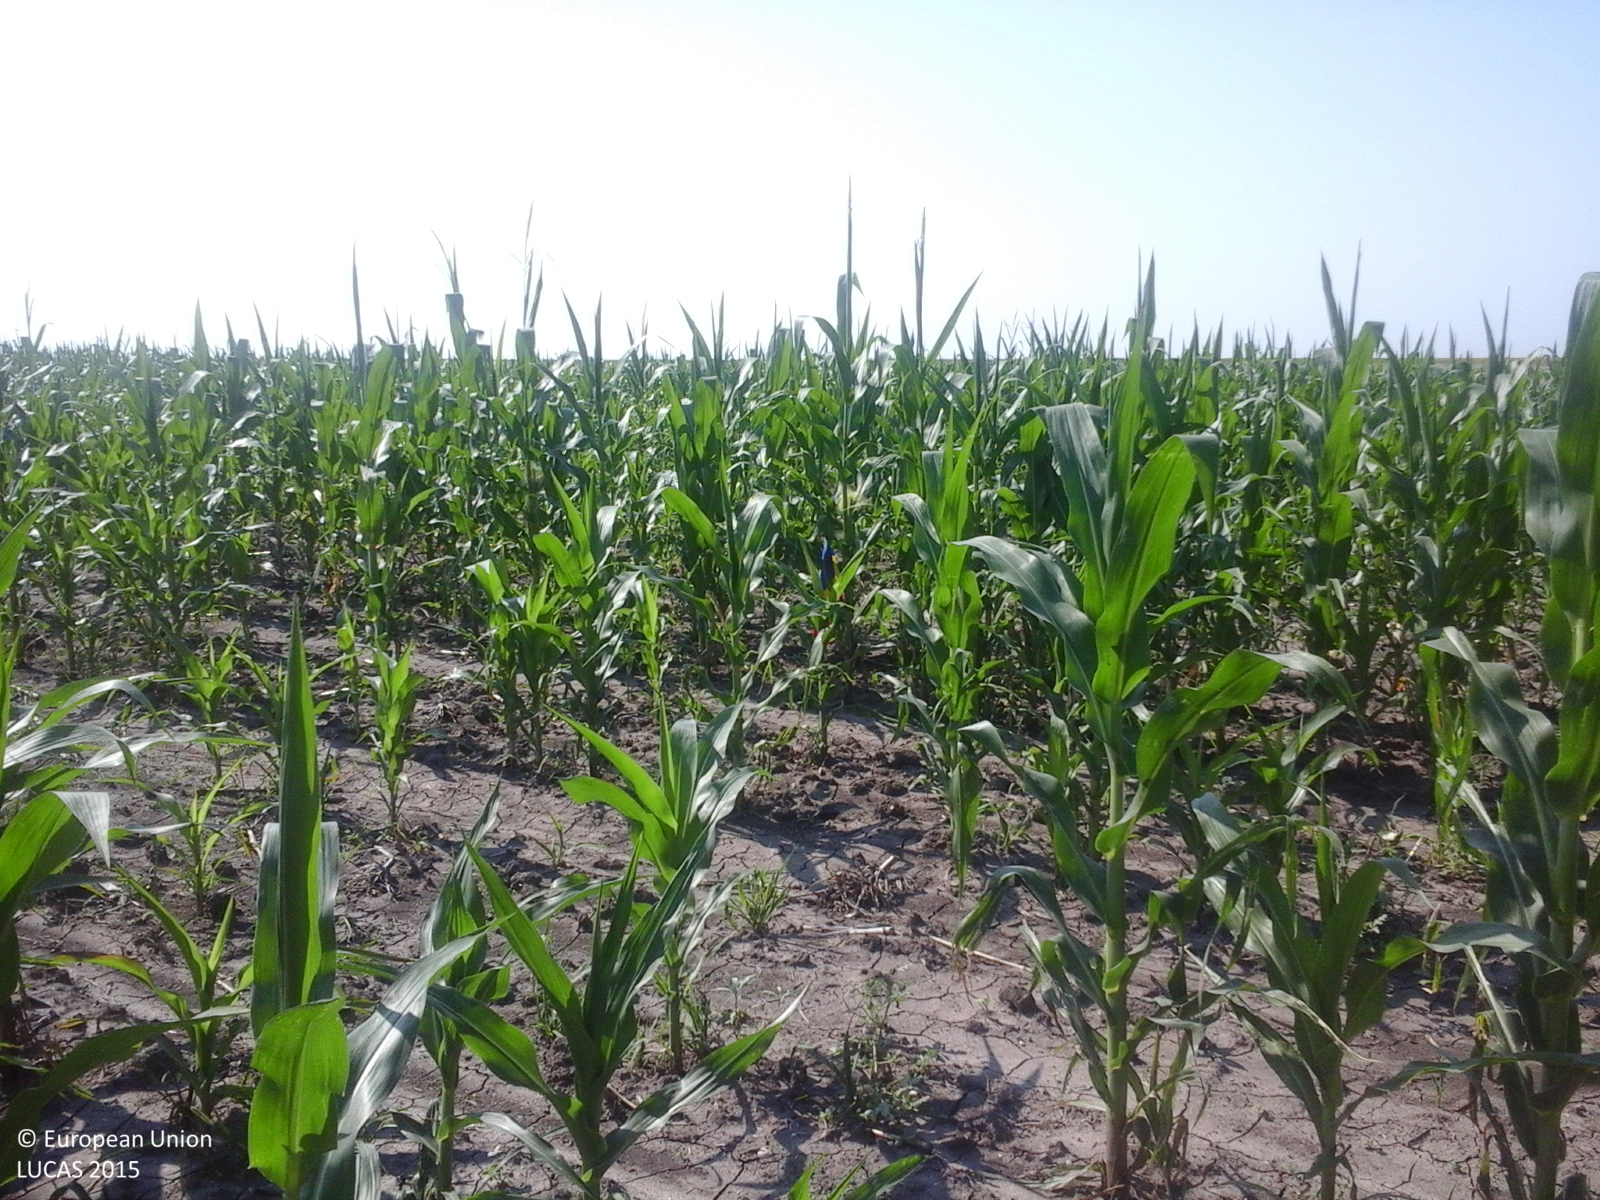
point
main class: Cropland
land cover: Maize
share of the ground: > 75 %
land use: Agriculture (excluding fallow land and kitchen gardens)
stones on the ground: < 10 %
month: July
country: RO
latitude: 44.5046
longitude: 24.8316
